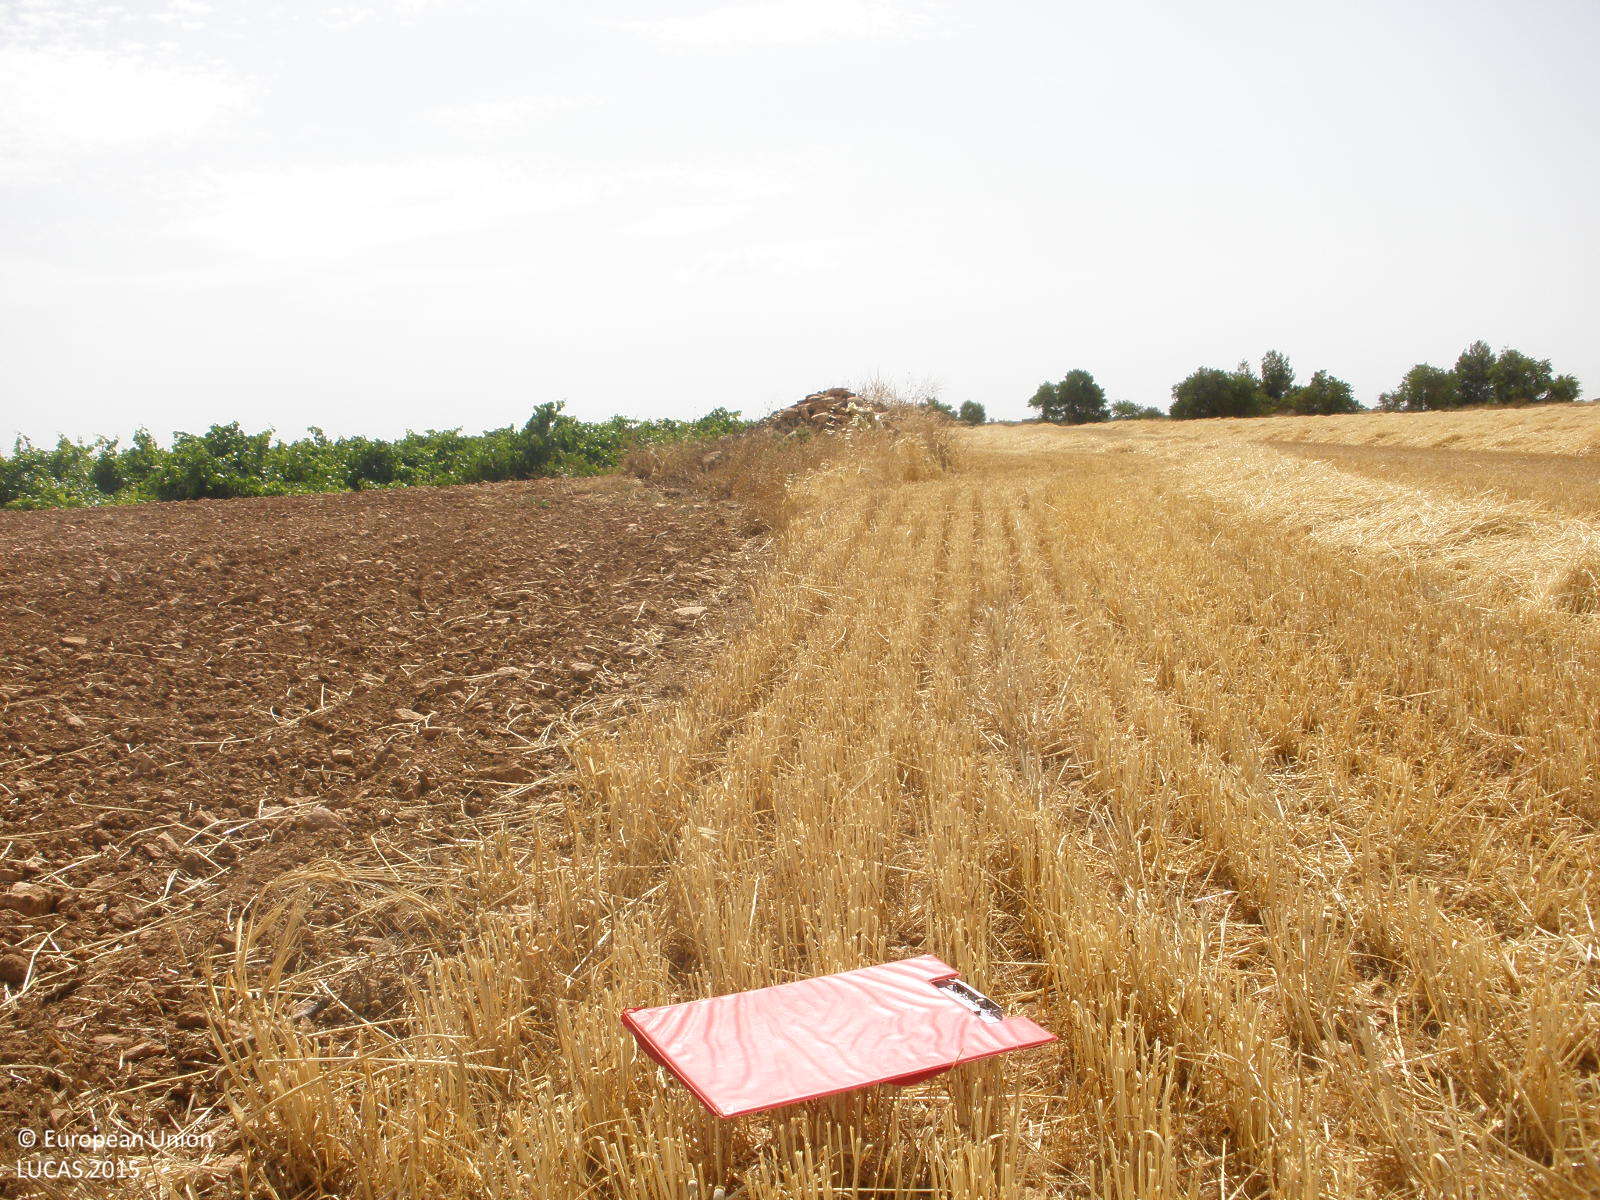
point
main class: Cropland
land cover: Barley
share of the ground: < 10 %
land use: Agriculture (excluding fallow land and kitchen gardens)
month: July
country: ES
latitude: 39.9019
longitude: -3.4671
